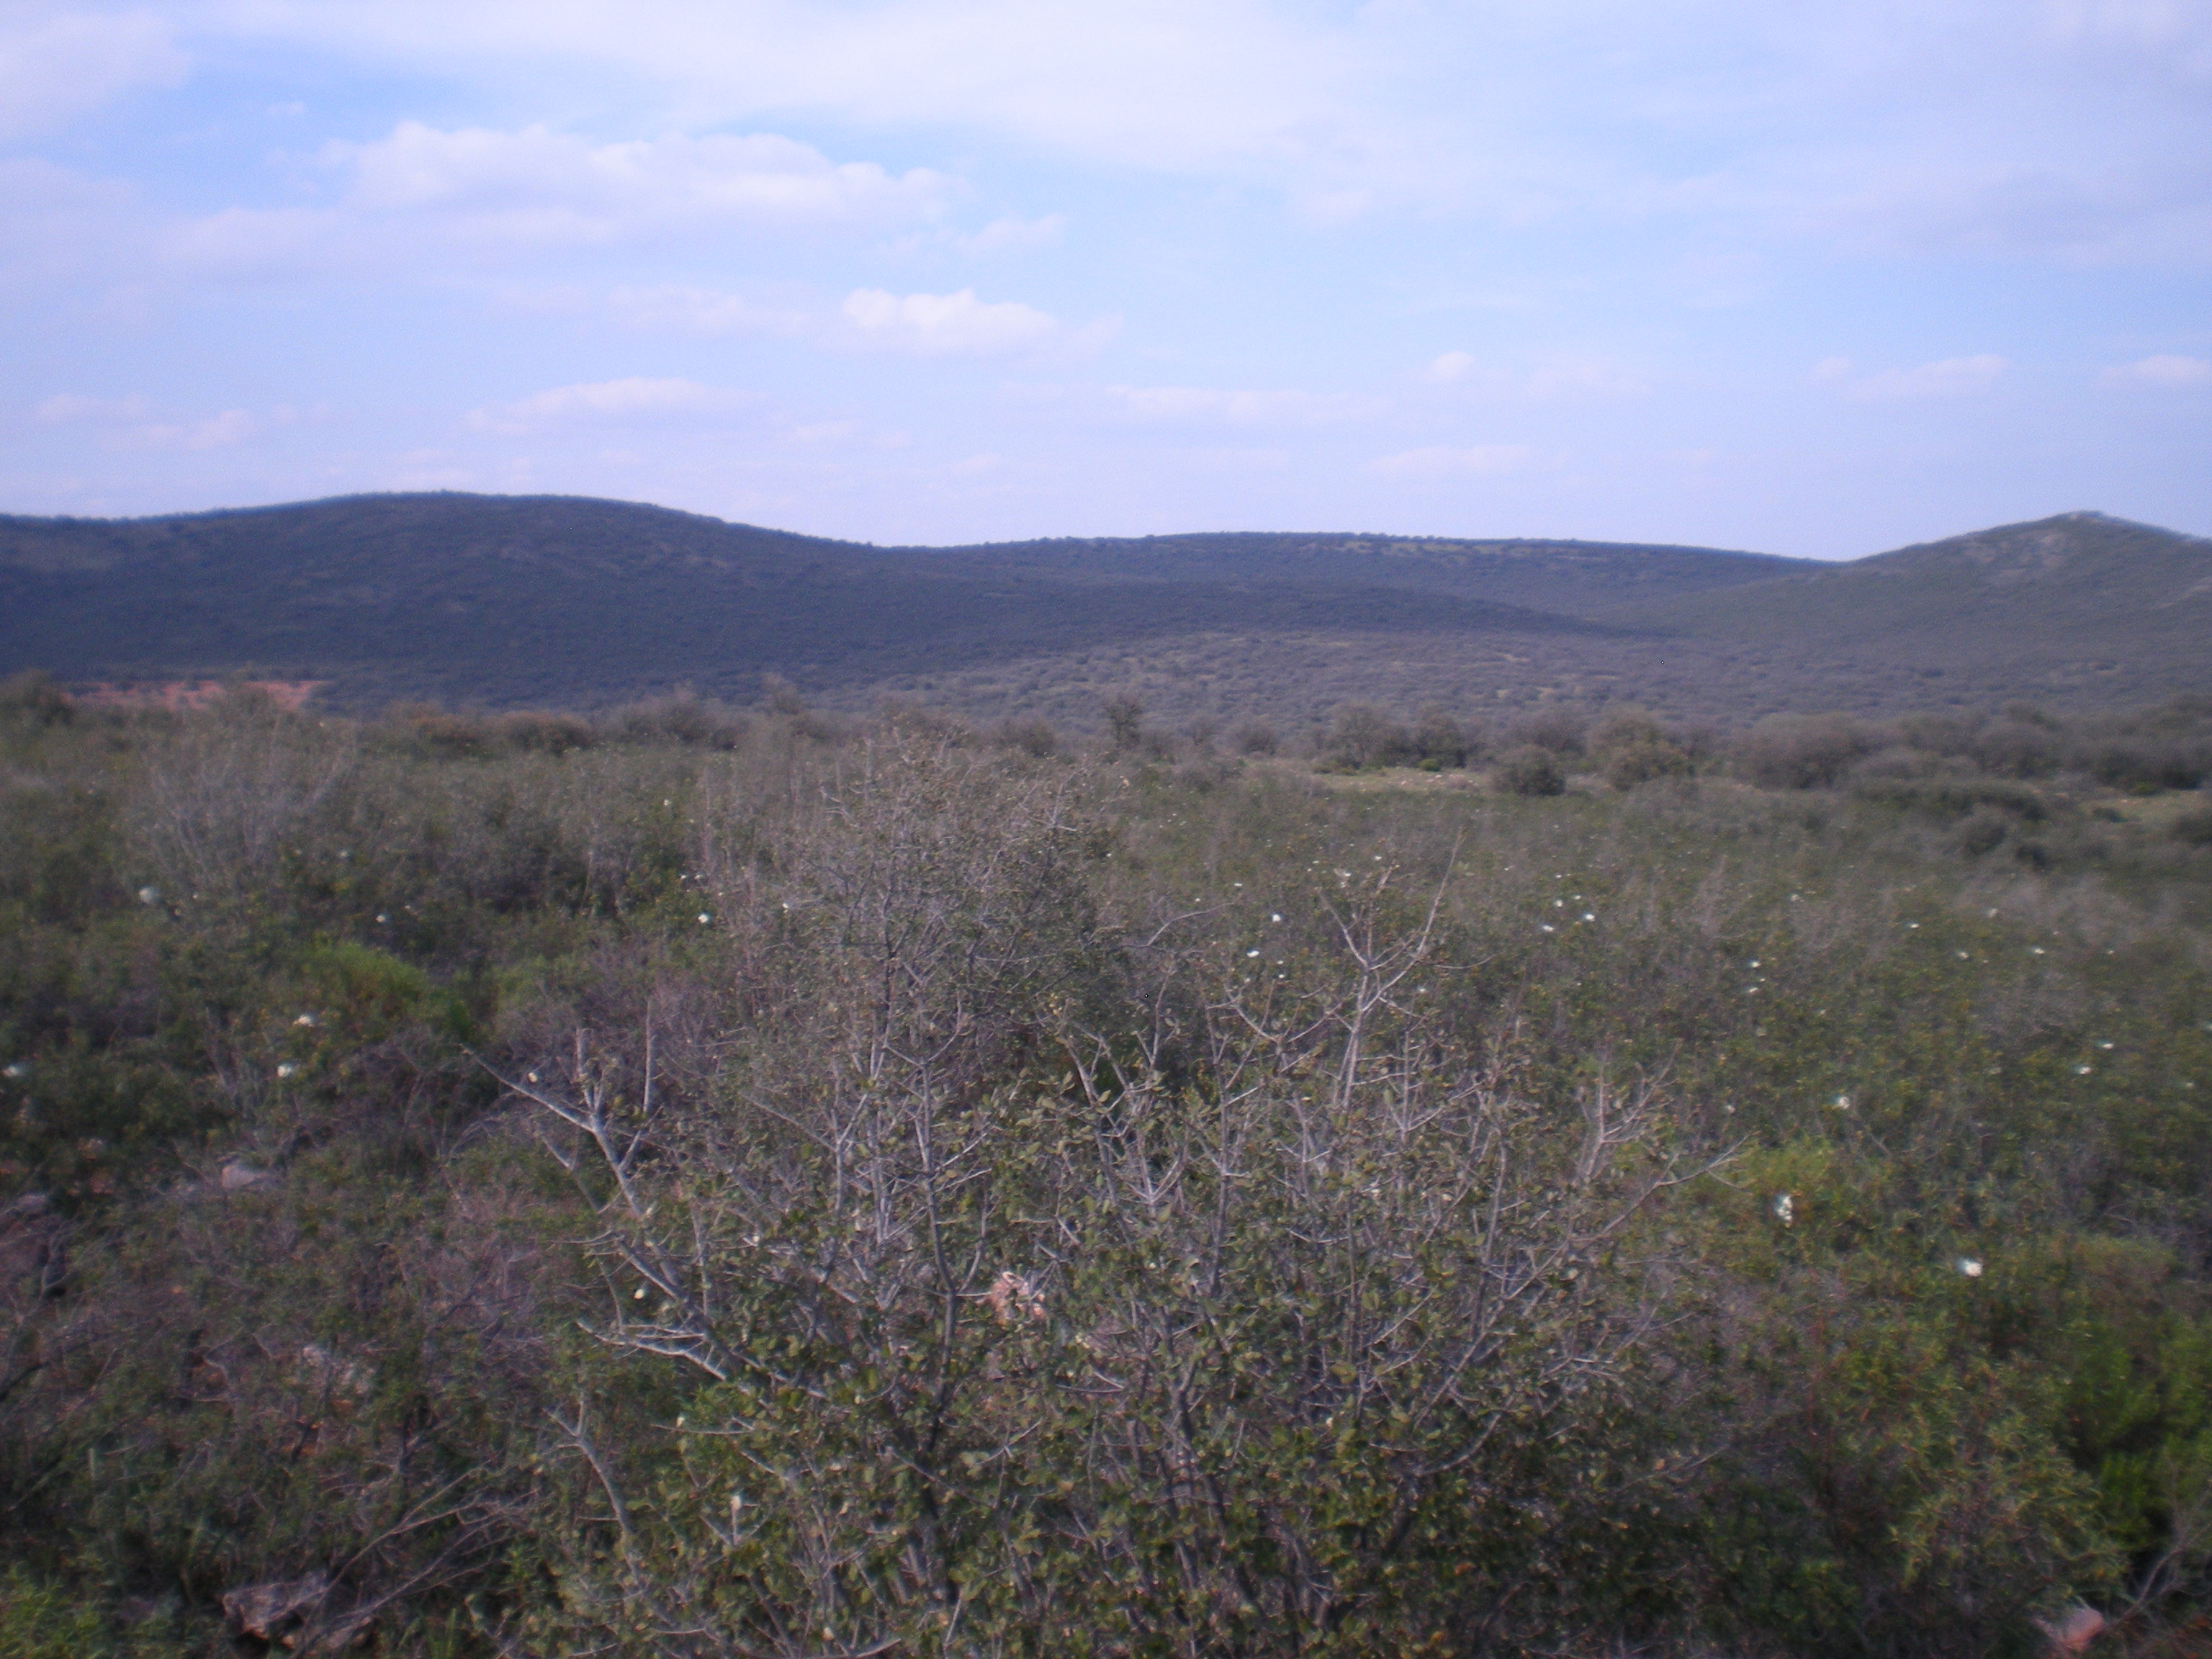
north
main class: Shrubland
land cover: Shrubland with sparse tree cover
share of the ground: > 75 %
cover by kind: shrubs 80 %, herbaceous plants 10 %, broadleaved forest trees 5 %, unconsolidated bare surface 5 %
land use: Other primary production
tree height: < 5 m
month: April
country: ES
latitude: 38.8846
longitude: -3.5367
